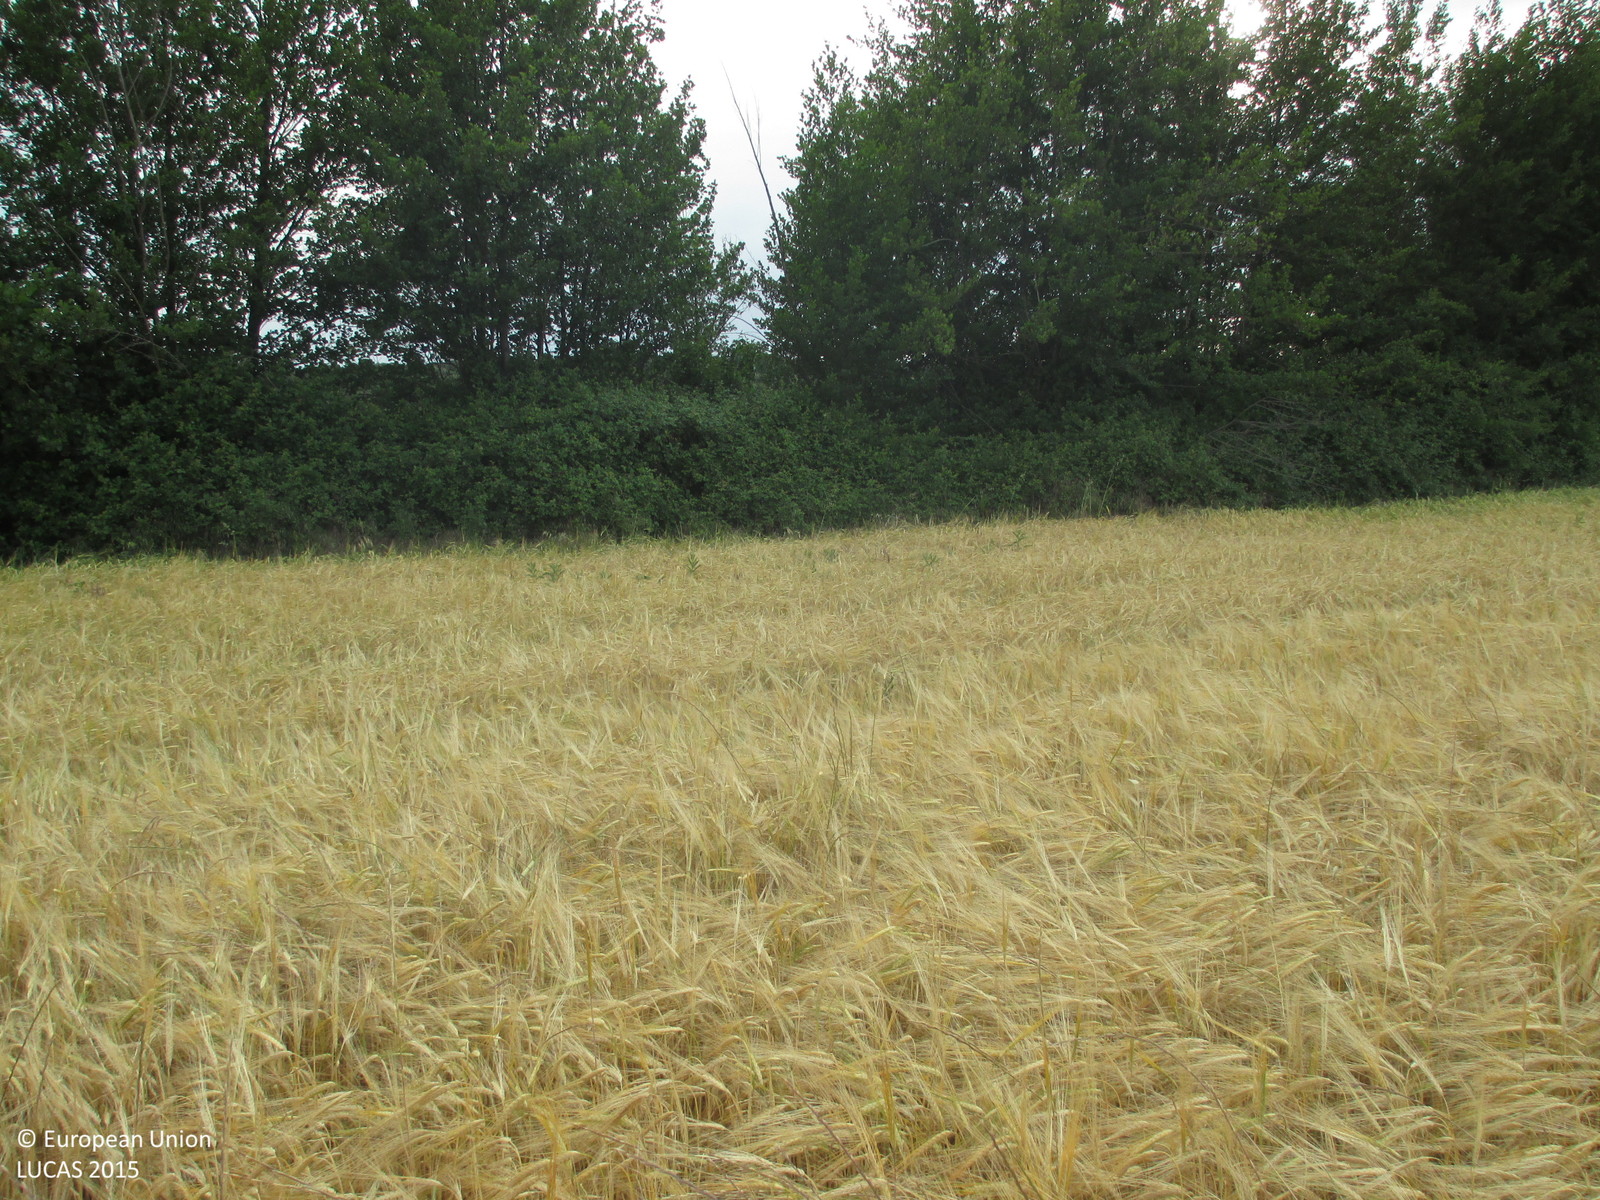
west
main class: Cropland
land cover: Barley
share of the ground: > 75 %
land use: Agriculture (excluding fallow land and kitchen gardens)
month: May
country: ES
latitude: 42.1308
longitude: -0.2682
